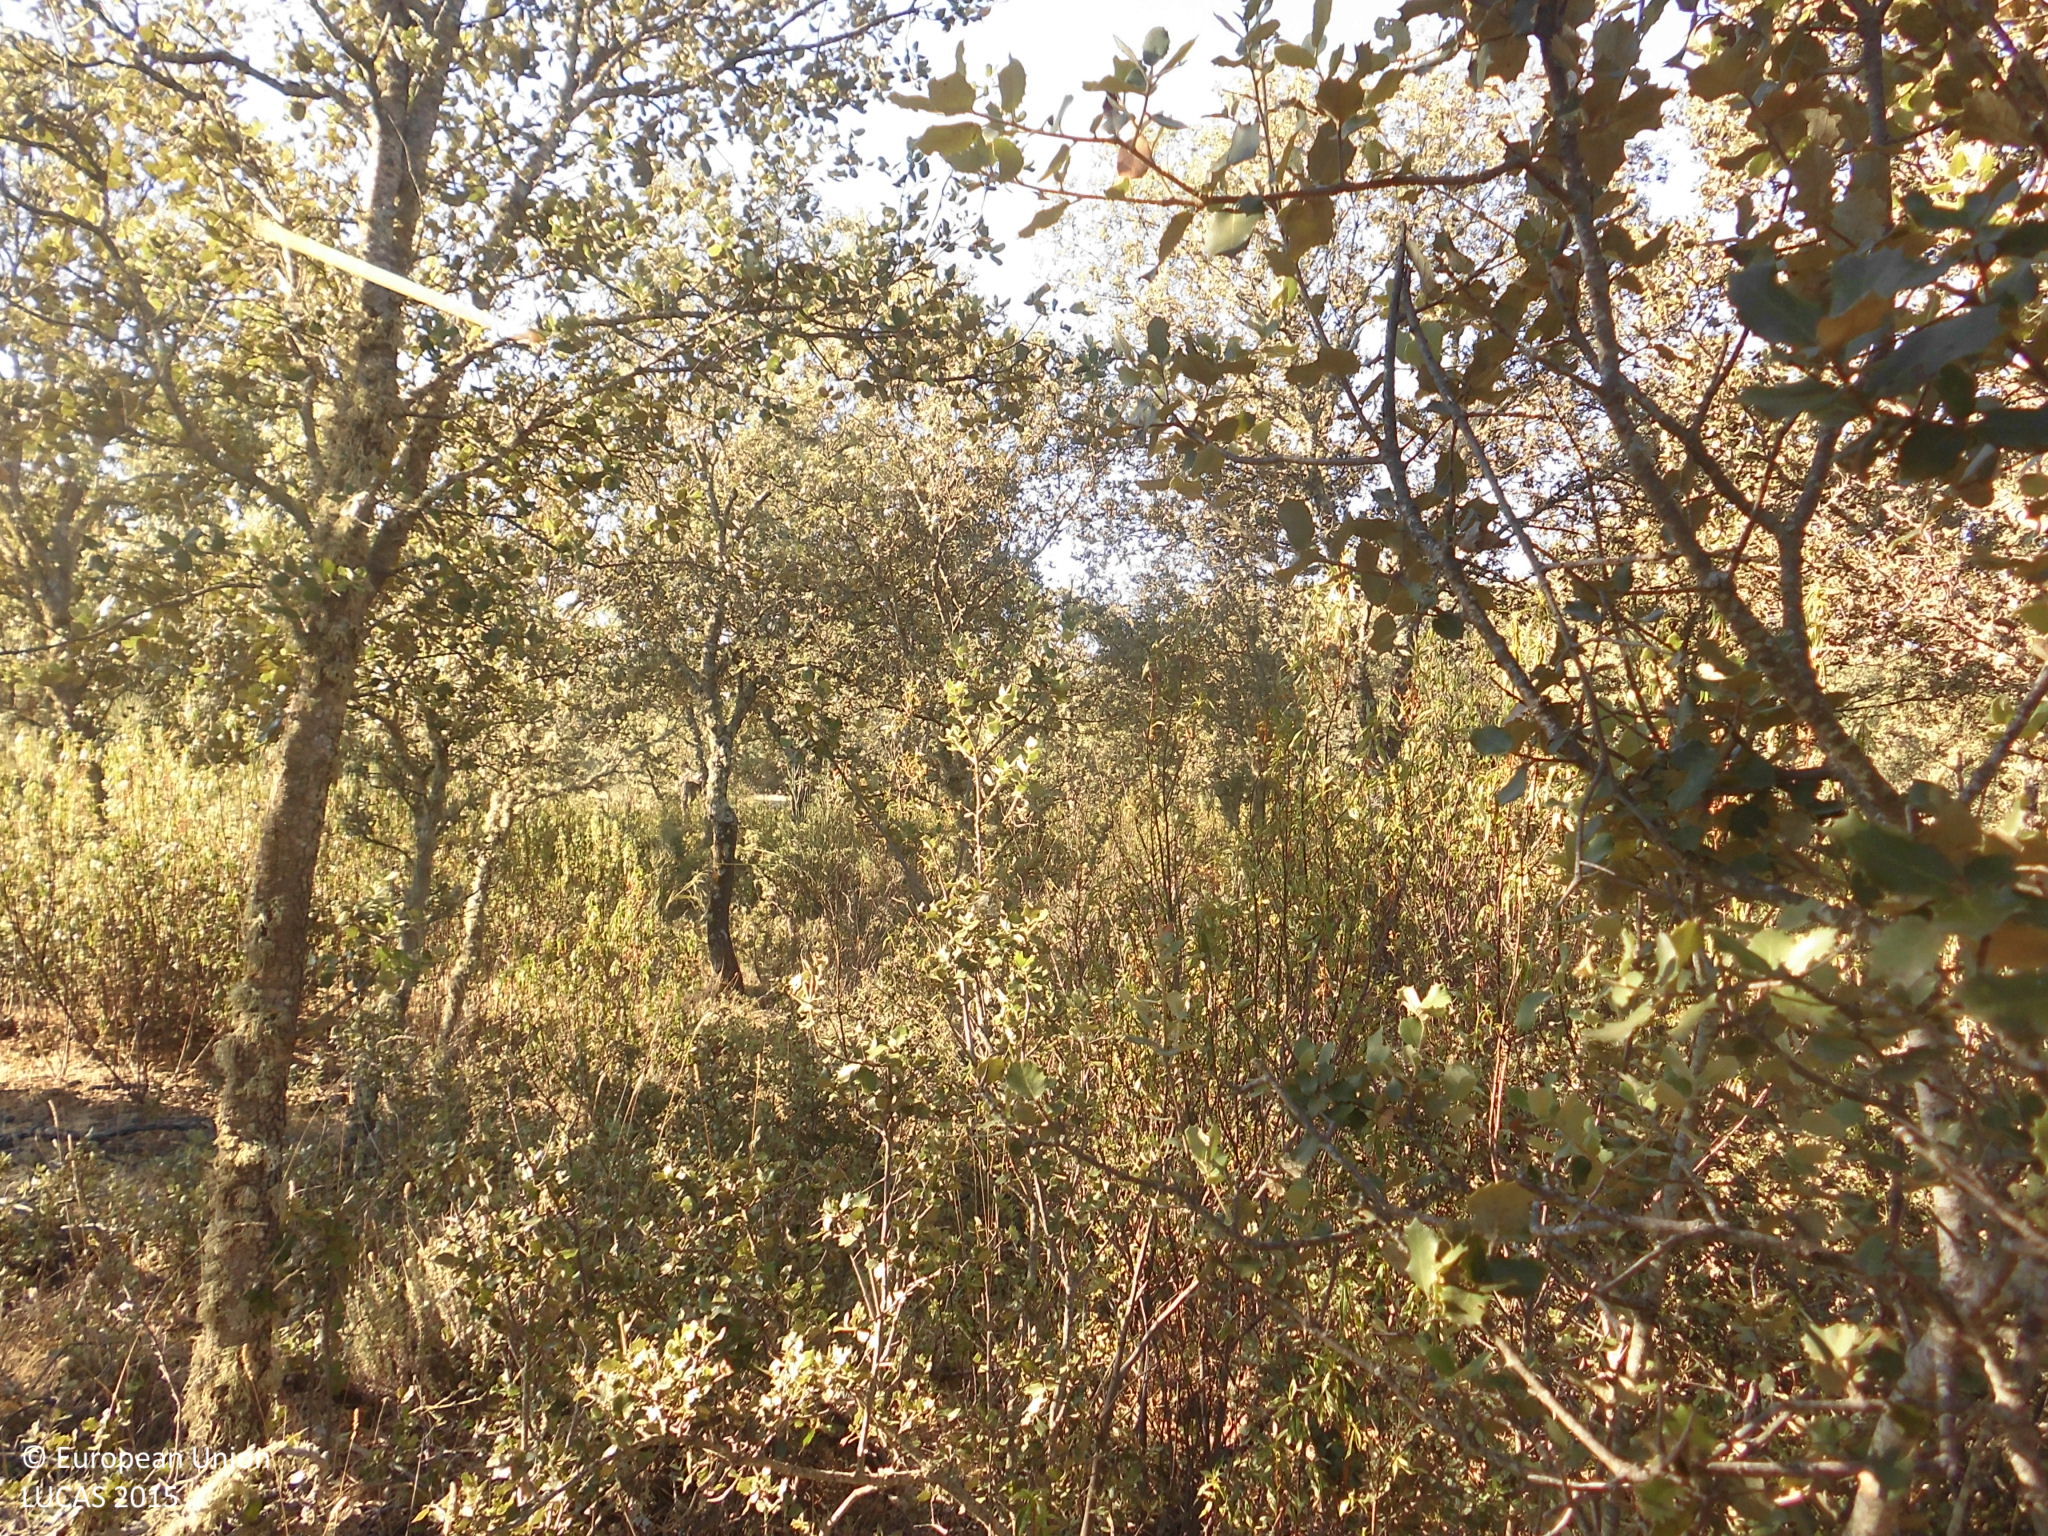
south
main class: Woodland
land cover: Broadleaved woodland
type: broadleaved evergreen forest
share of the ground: 25 - 50 %
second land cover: Shrubland without tree cover
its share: 10 - 25 %
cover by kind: broadleaved forest trees 45 %, herbaceous plants 35 %, shrubs 20 %
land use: Forestry
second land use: Agriculture (excluding fallow land and kitchen gardens)
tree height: > 5 m
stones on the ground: 10 - 25 %
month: July
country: ES
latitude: 39.7860
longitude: -5.6954
